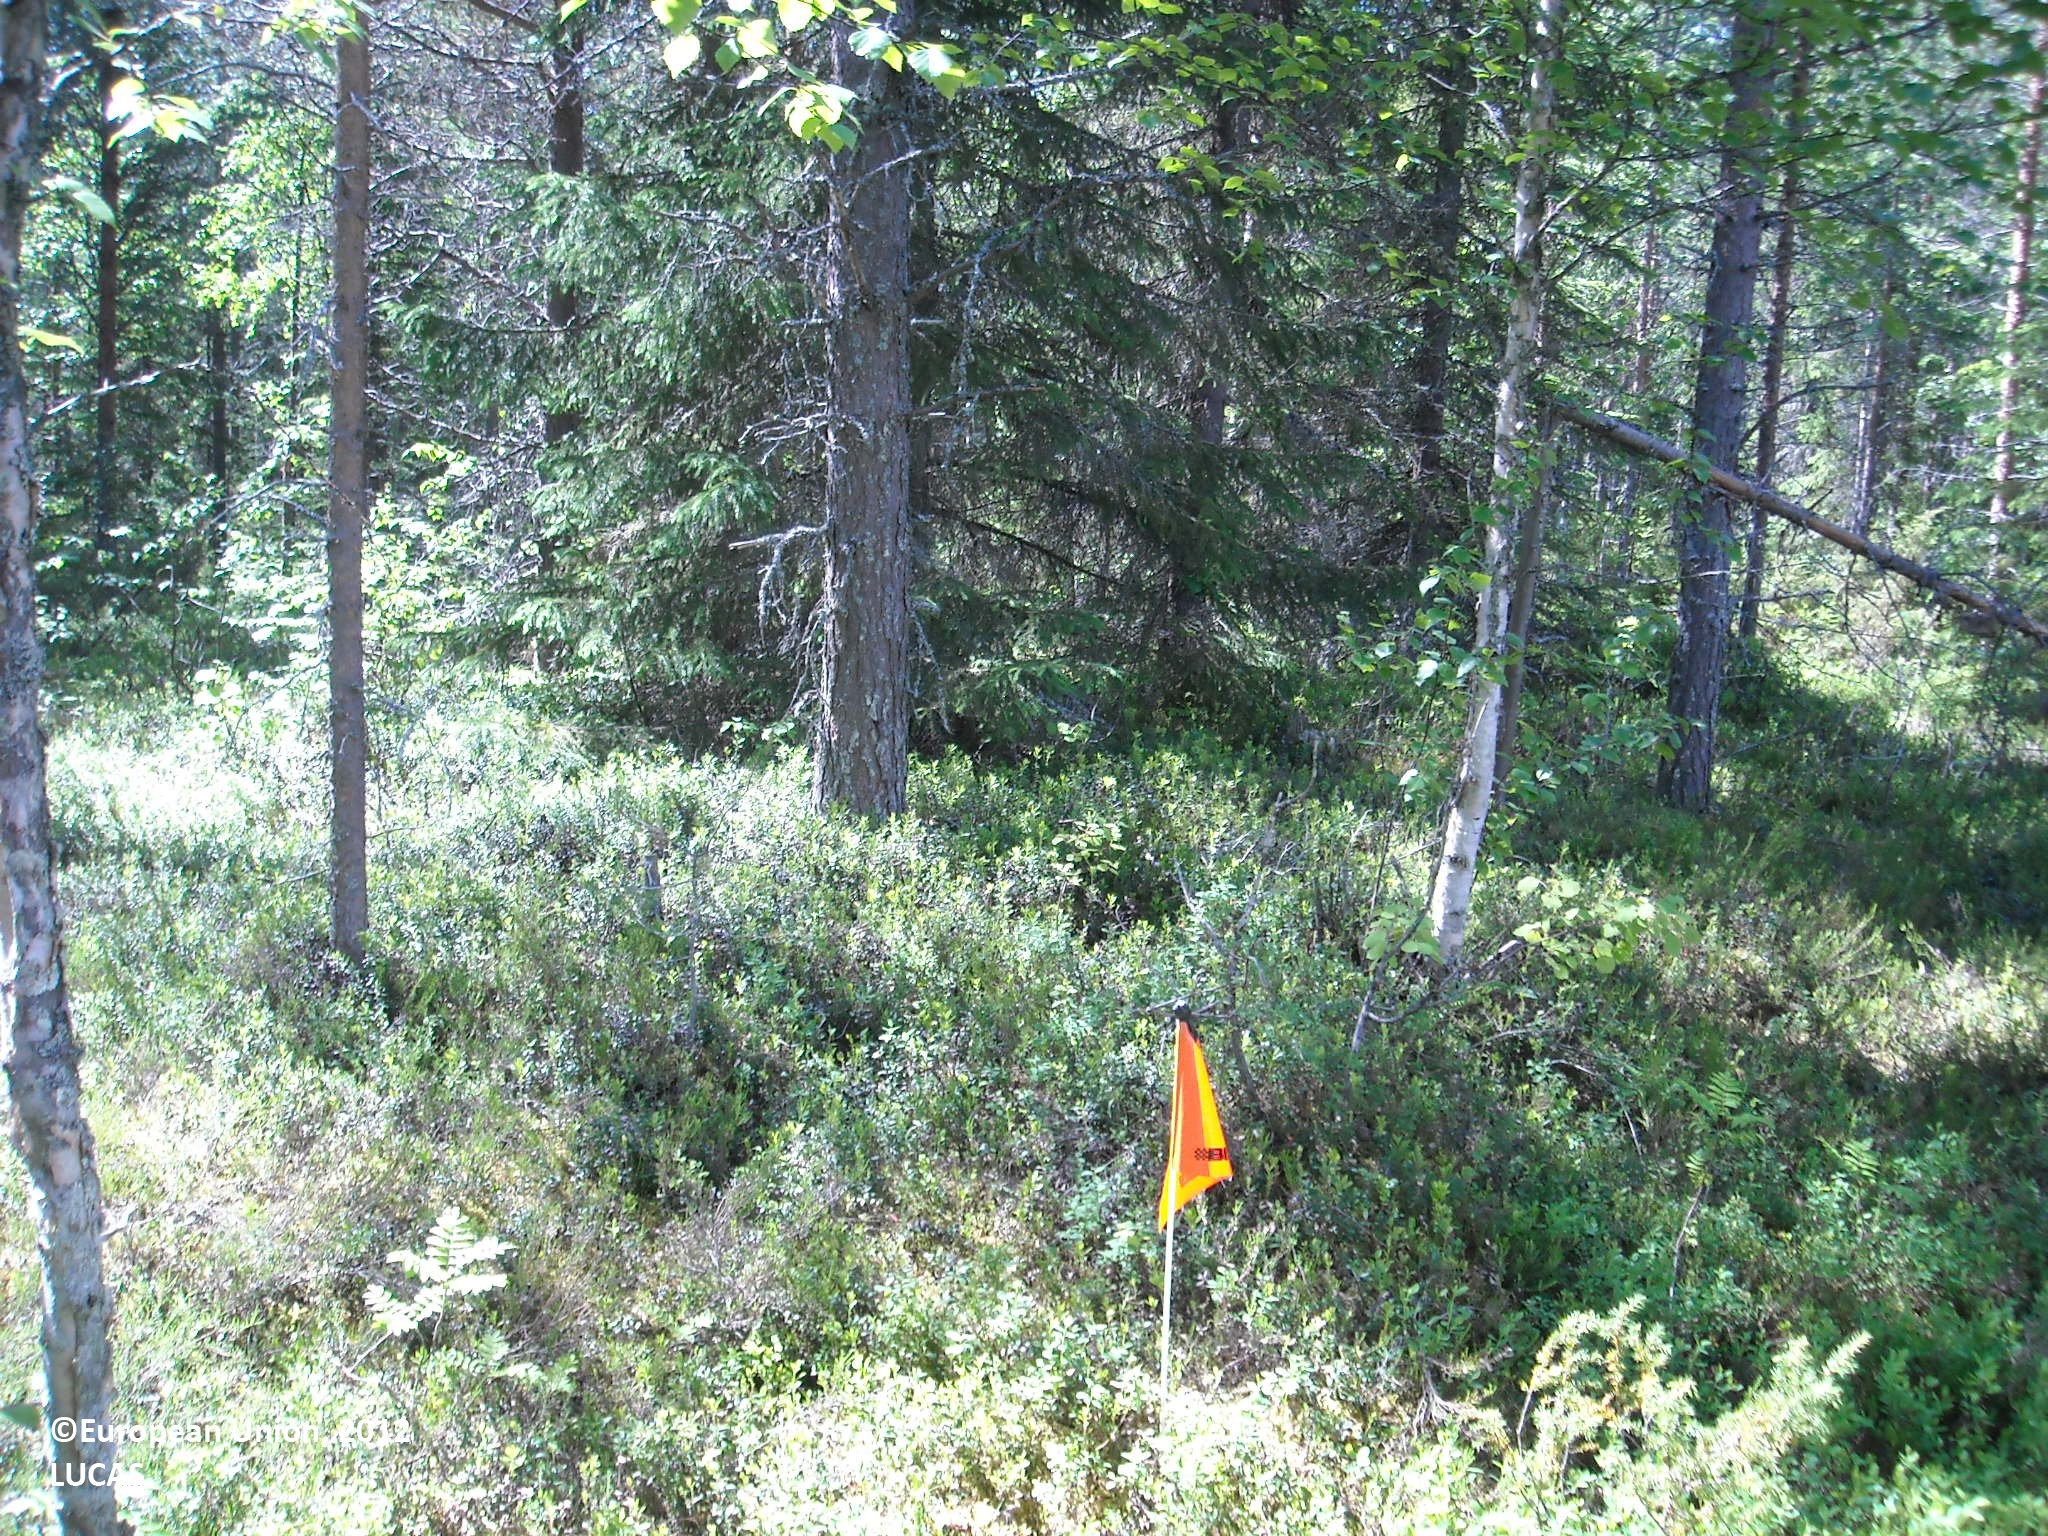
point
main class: Woodland
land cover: Other coniferous woodland
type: boreal forest
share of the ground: > 75 %
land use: Forestry
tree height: > 5 m
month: July
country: FI
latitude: 64.7998
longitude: 27.4181
